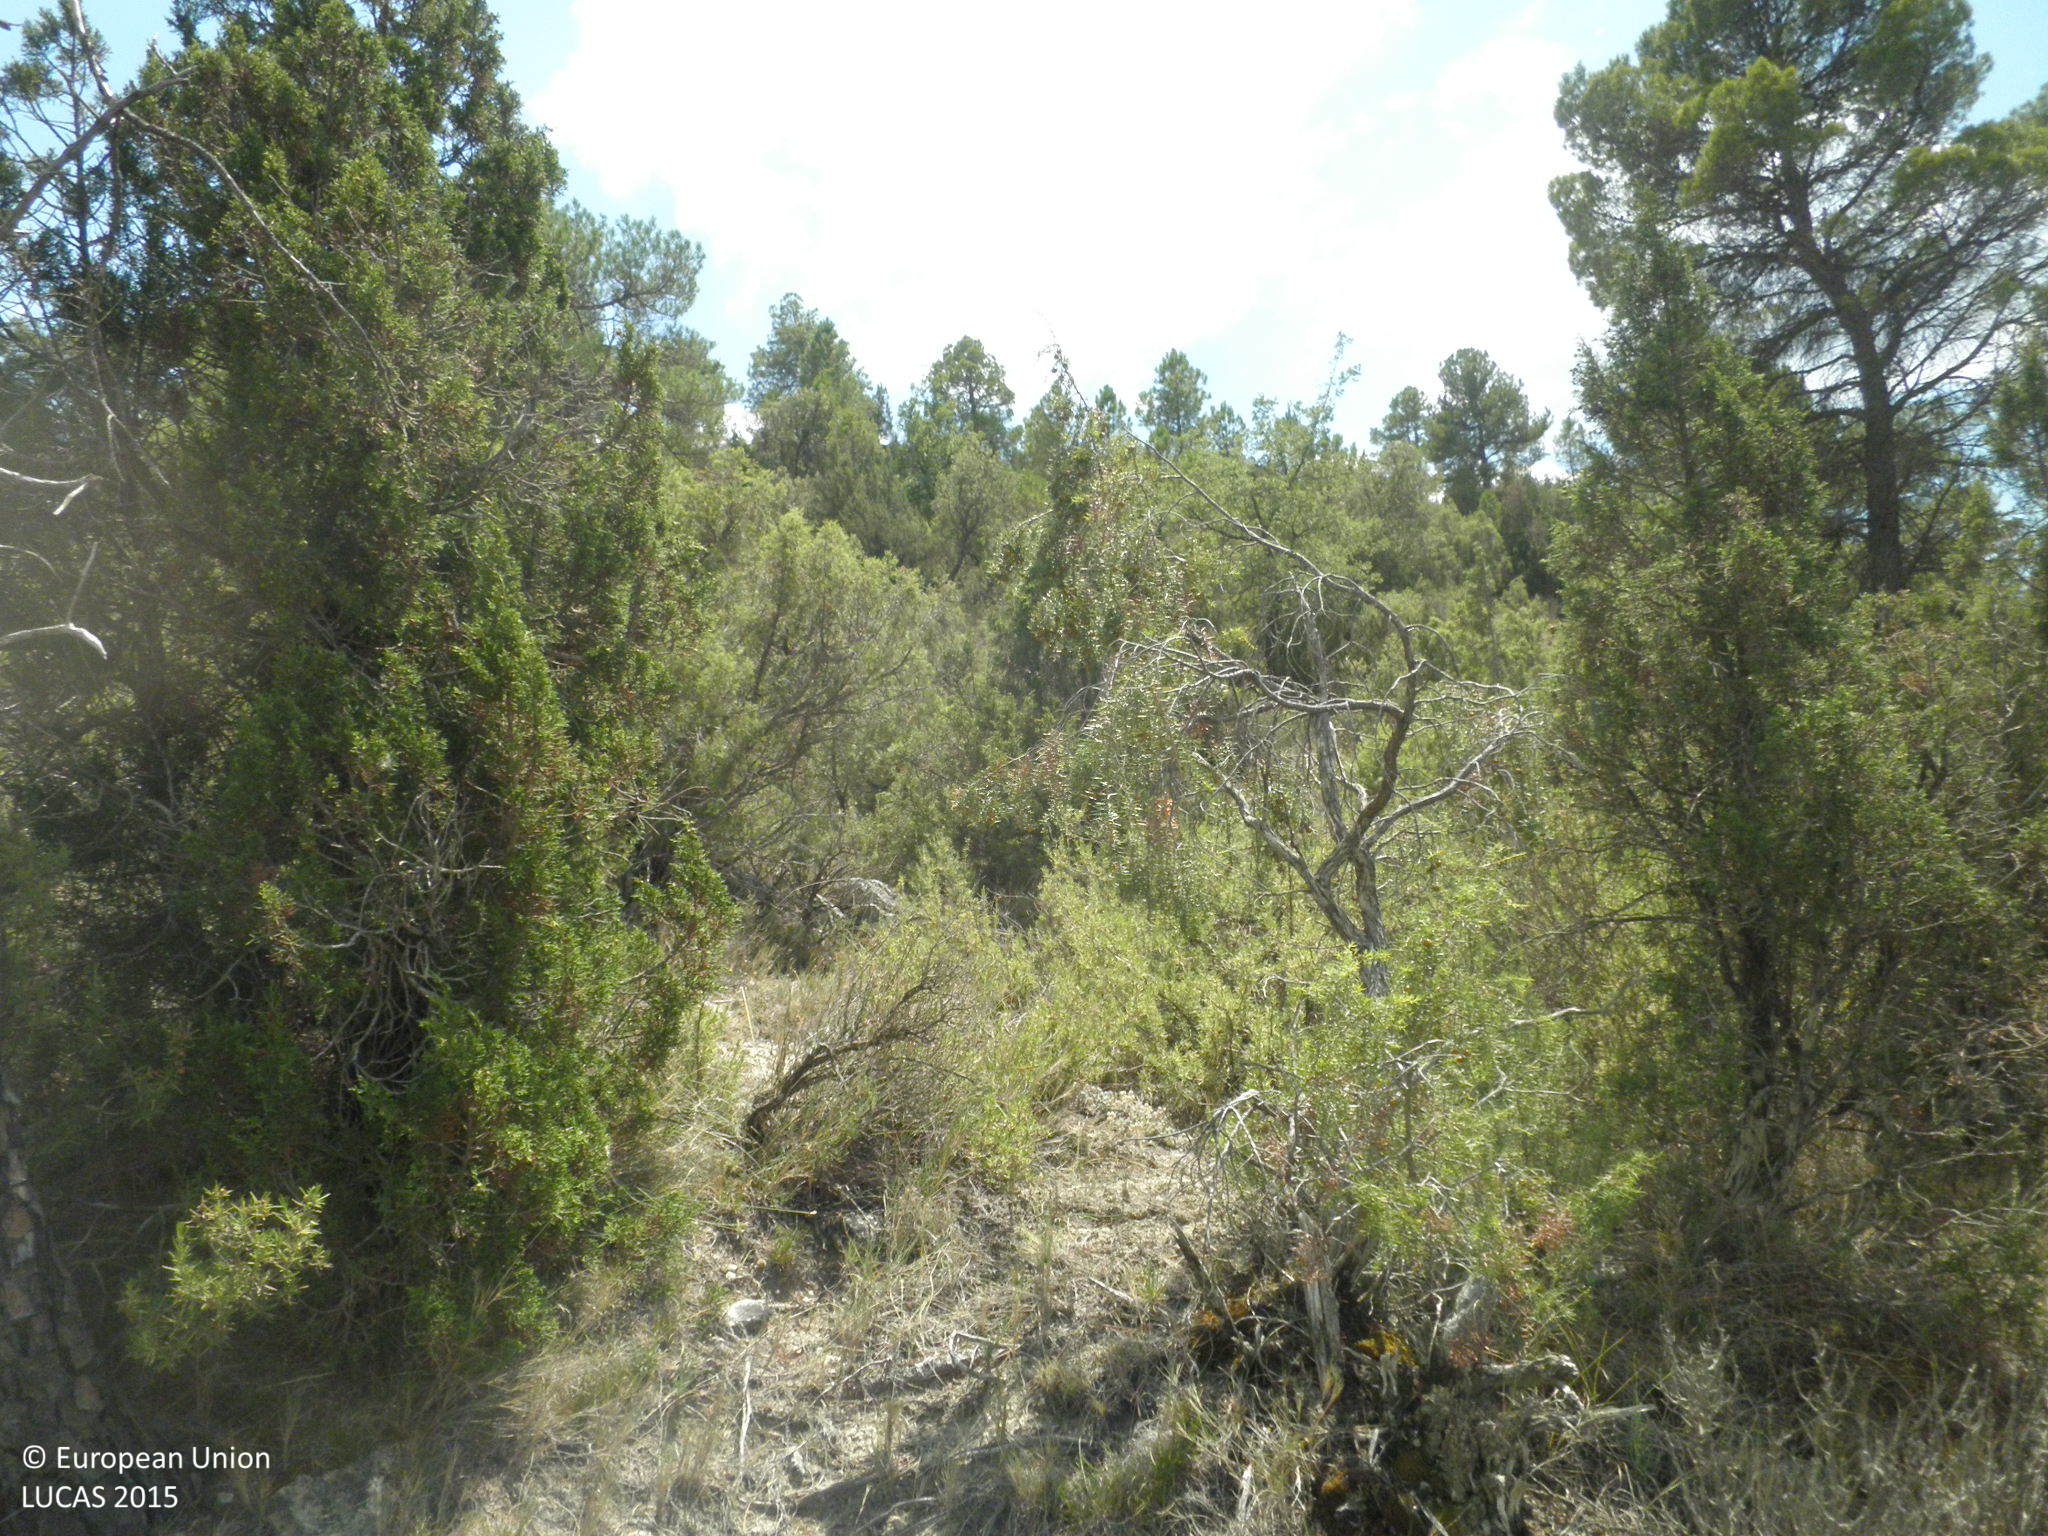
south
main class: Woodland
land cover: Pine dominated coniferous woodland
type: coniferous forest of the mediterranean region
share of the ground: 10 - 25 %
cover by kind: unconsolidated bare surface 50 %, shrubs 40 %, coniferous forest trees 10 %
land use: Semi-natural and natural areas not in use
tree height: > 5 m
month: July
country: ES
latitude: 39.7346
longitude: -1.8056
